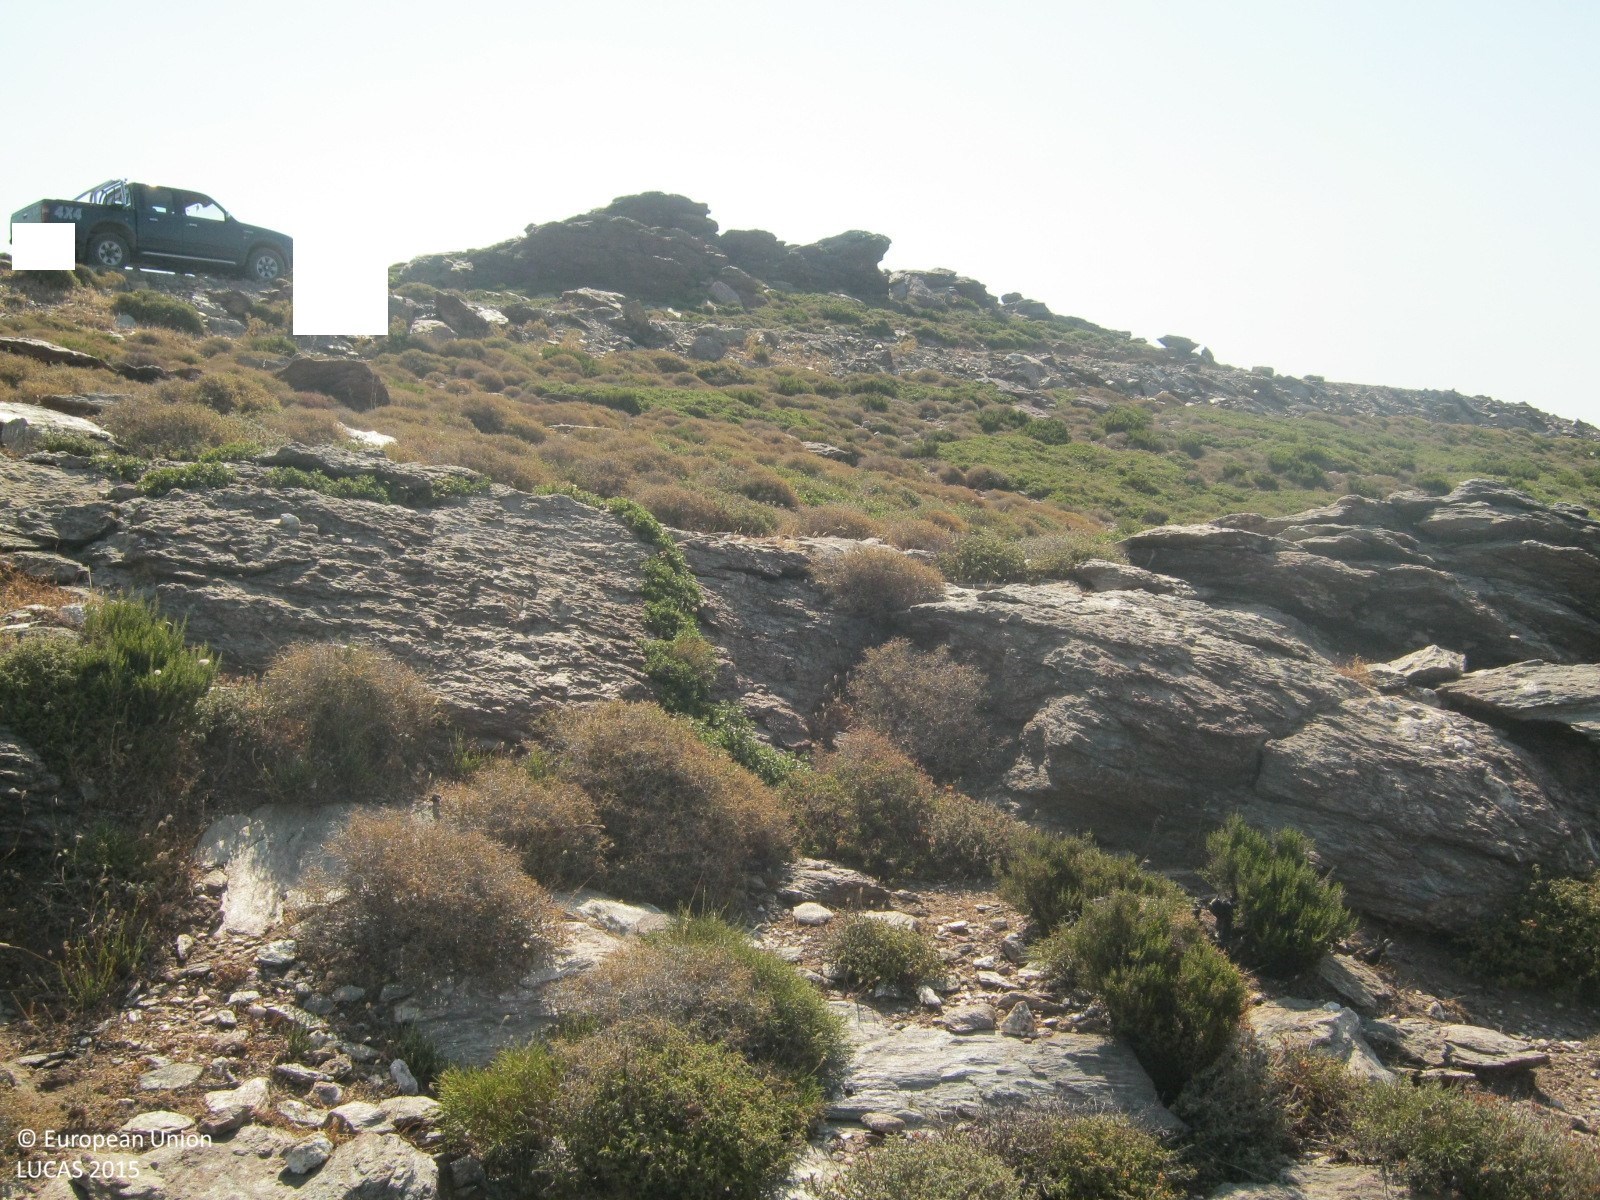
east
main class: Shrubland
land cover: Shrubland without tree cover
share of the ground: 50 - 75 %
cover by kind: shrubs 65 %, herbaceous plants 25 %, unconsolidated bare surface 10 %
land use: Agriculture (excluding fallow land and kitchen gardens)
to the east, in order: Shrubland without tree cover; Rock outcrops; Paved roads, cycling and walking lanes; Rock outcrops; Shrubland without tree cover; Rock outcrops; Shrubland without tree cover; Rock outcrops; Shrubland without tree cover; Rock outcrops; Shrubland without tree cover
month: July
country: GR
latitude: 38.0103
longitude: 24.4887
